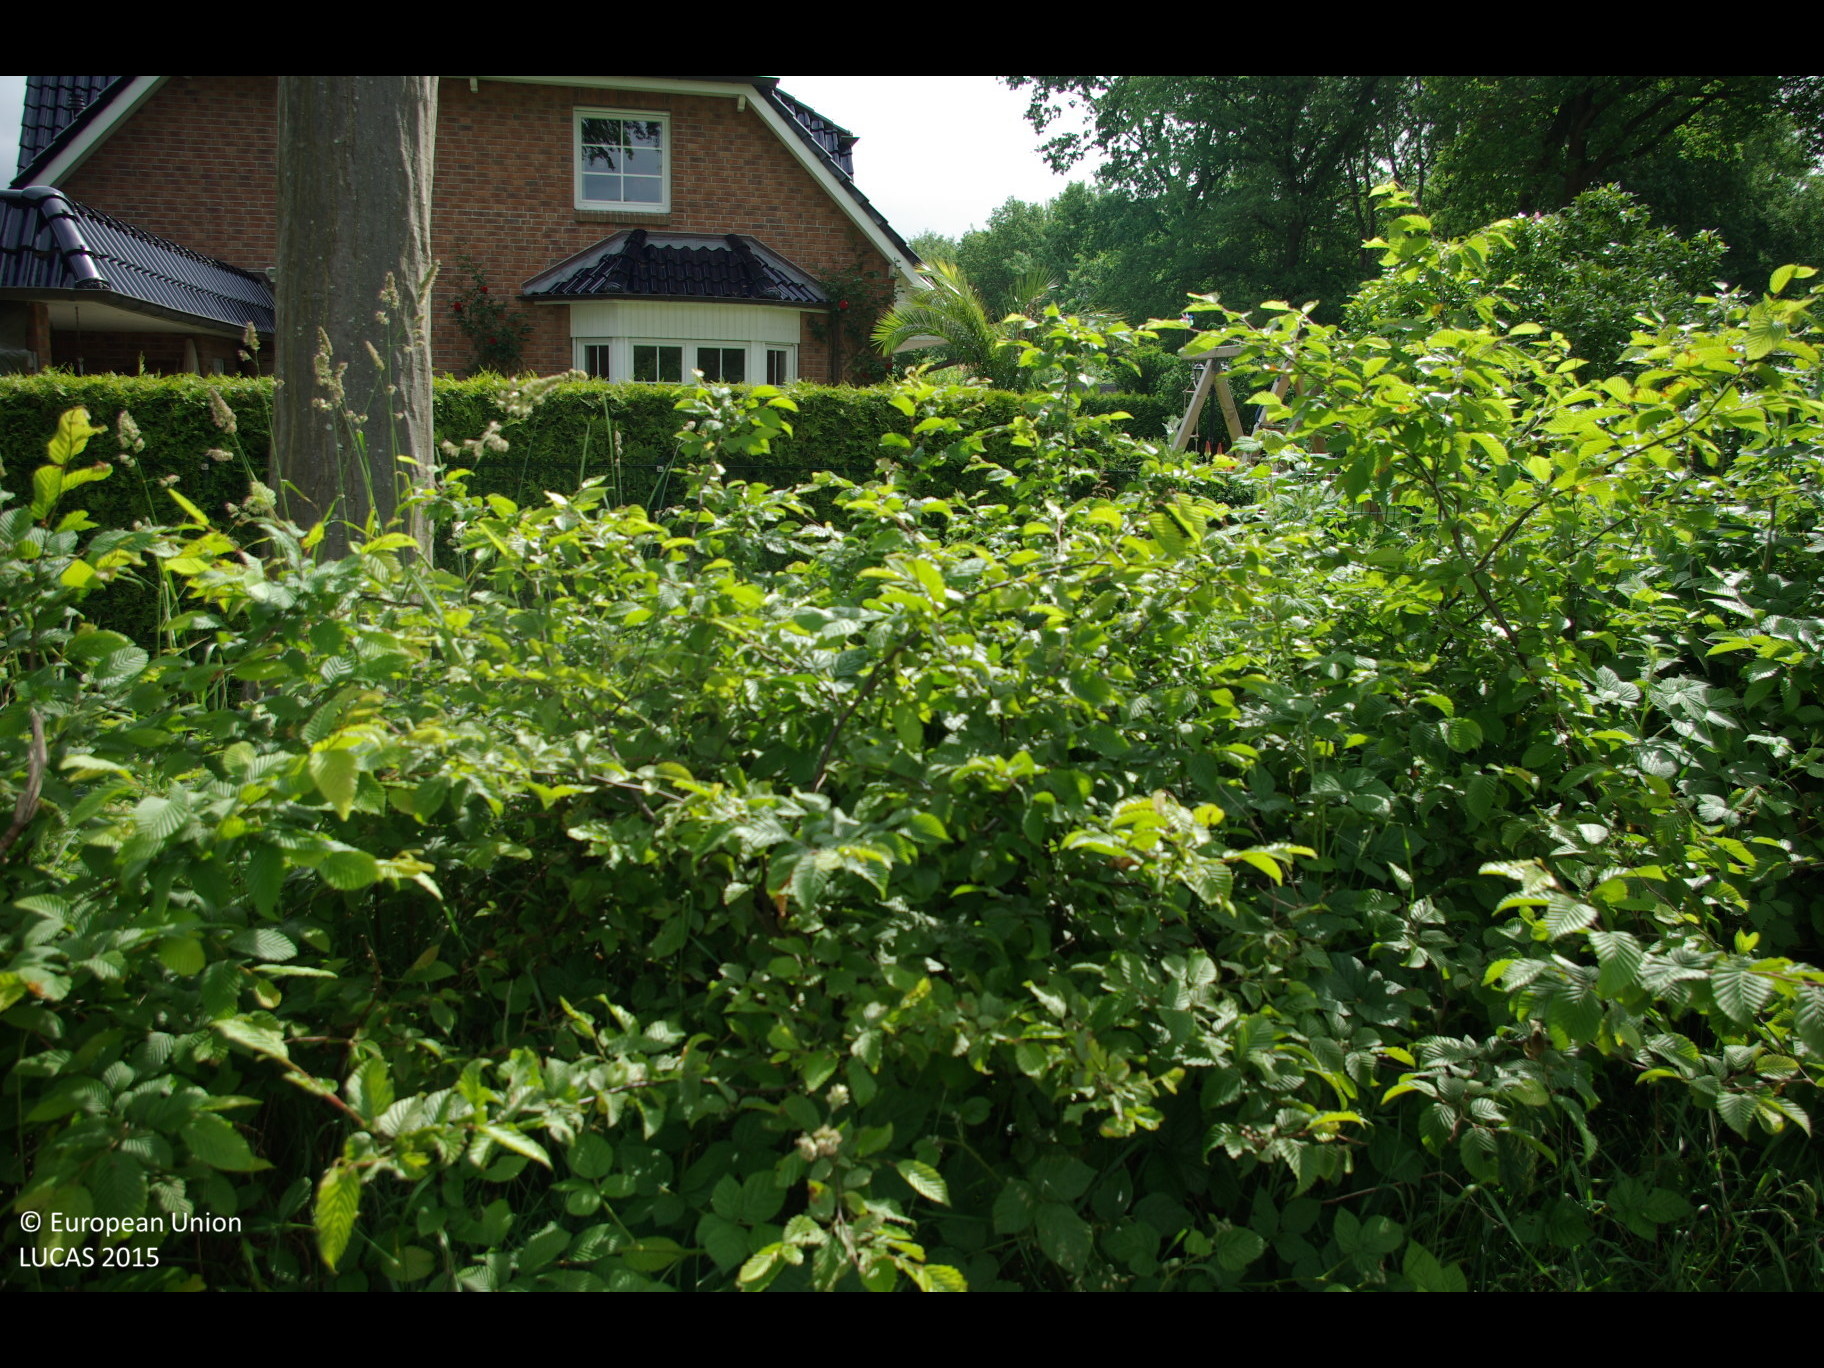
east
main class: Grassland
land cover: Grassland without tree/shrub cover
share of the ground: > 75 %
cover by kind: herbaceous plants 100 %
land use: Residential
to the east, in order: Grassland without tree/shrub cover; Lines of trees; Artificial constructions in urban areas; Grassland without tree/shrub cover; Broadleaved woodland; Artificial constructions in urban areas
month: June
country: DE
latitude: 54.0489
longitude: 9.9542
